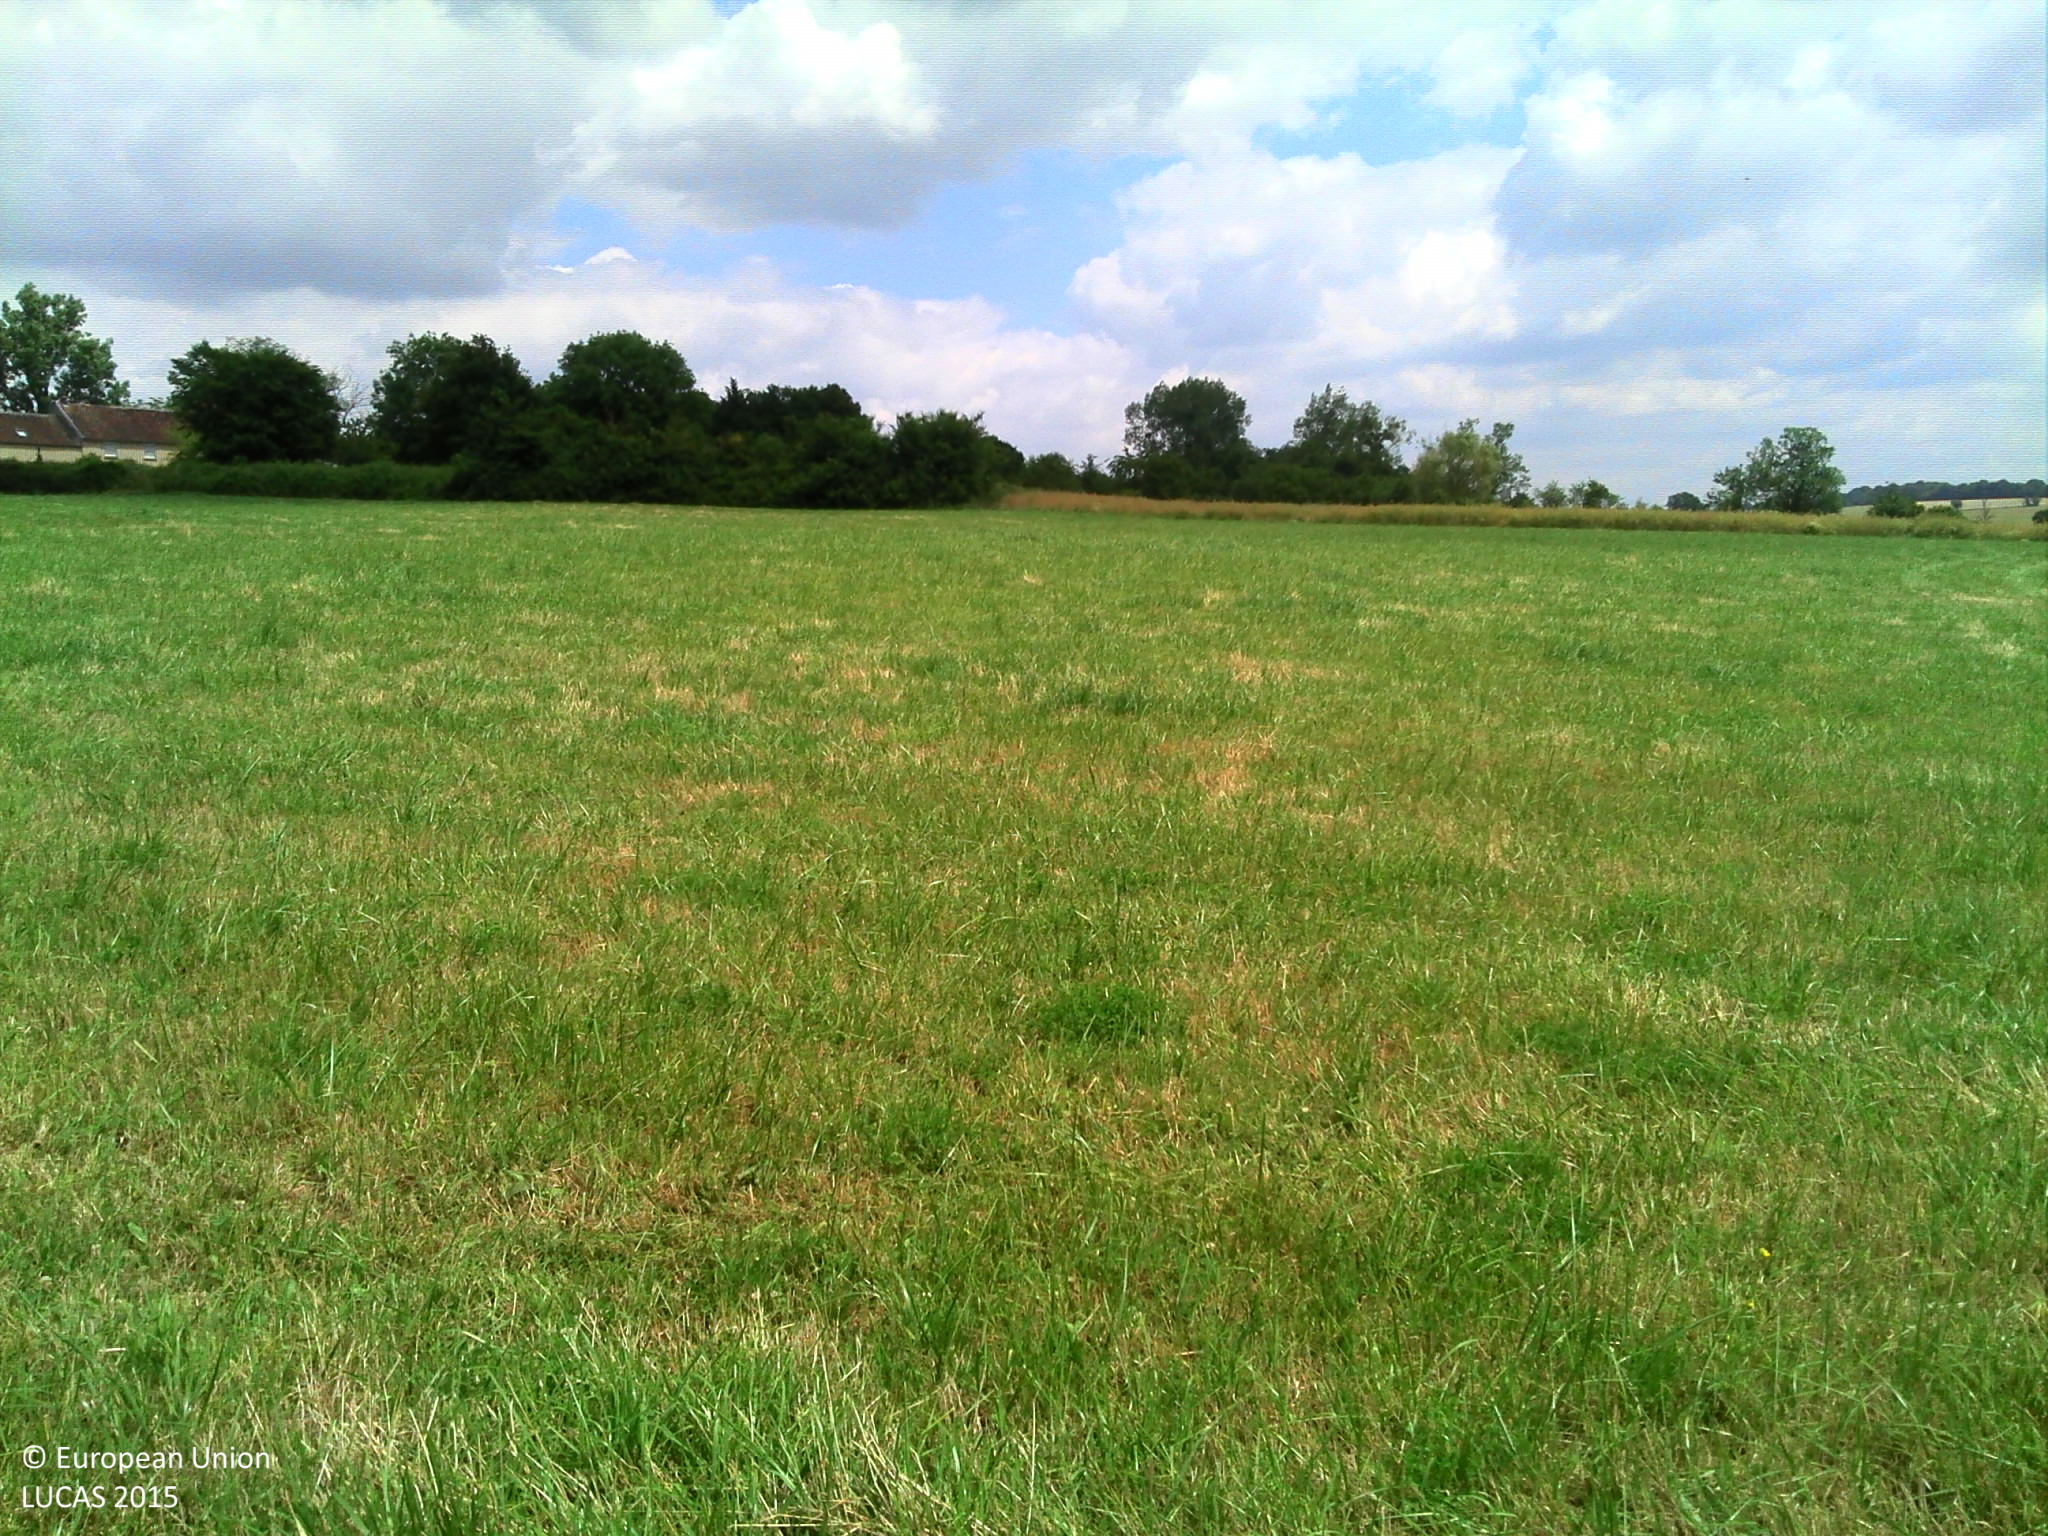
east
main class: Grassland
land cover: Grassland without tree/shrub cover
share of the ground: > 75 %
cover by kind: herbaceous plants 100 %
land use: Agriculture (excluding fallow land and kitchen gardens)
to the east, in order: Grassland without tree/shrub cover; Rape and turnip rape; Grass margins; Tracks; Fences; Managed hedges; Spontaneously vegetated surfaces
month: June
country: FR
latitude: 47.5035
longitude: 3.1311
